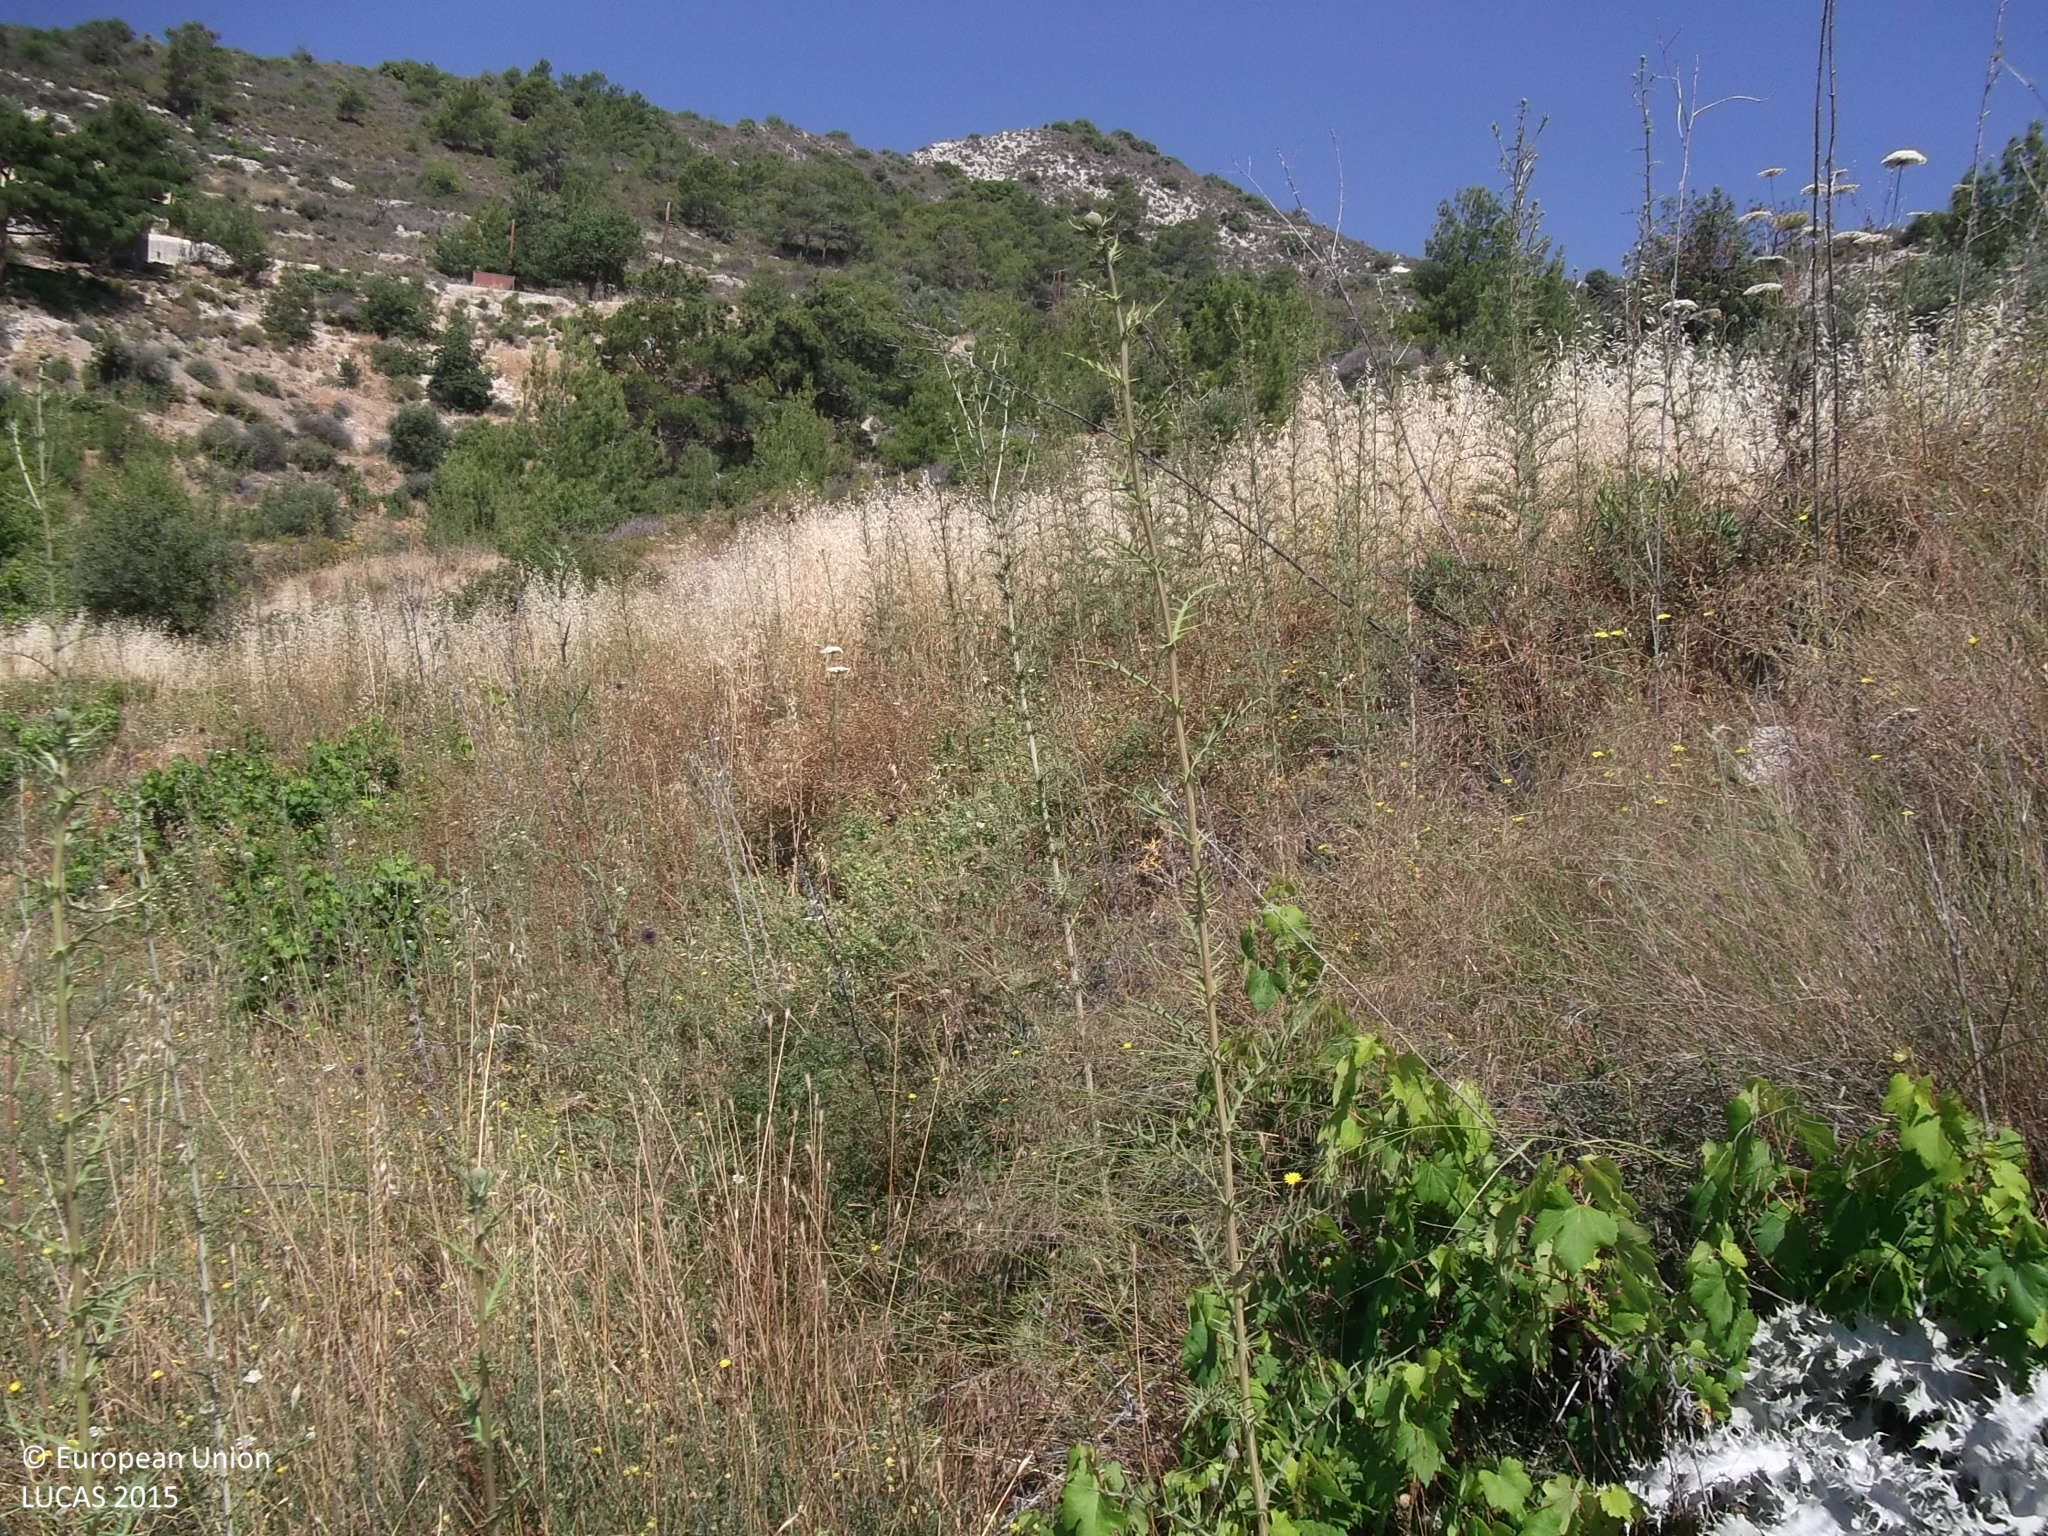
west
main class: Woodland
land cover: Pine dominated coniferous woodland
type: coniferous forest of the mediterranean region
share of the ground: 10 - 25 %
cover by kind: unconsolidated bare surface 35 %, coniferous forest trees 25 %, shrubs 20 %, herbaceous plants 20 %
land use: Semi-natural and natural areas not in use
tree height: > 5 m
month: June
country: CY
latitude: 34.8451
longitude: 32.9467
